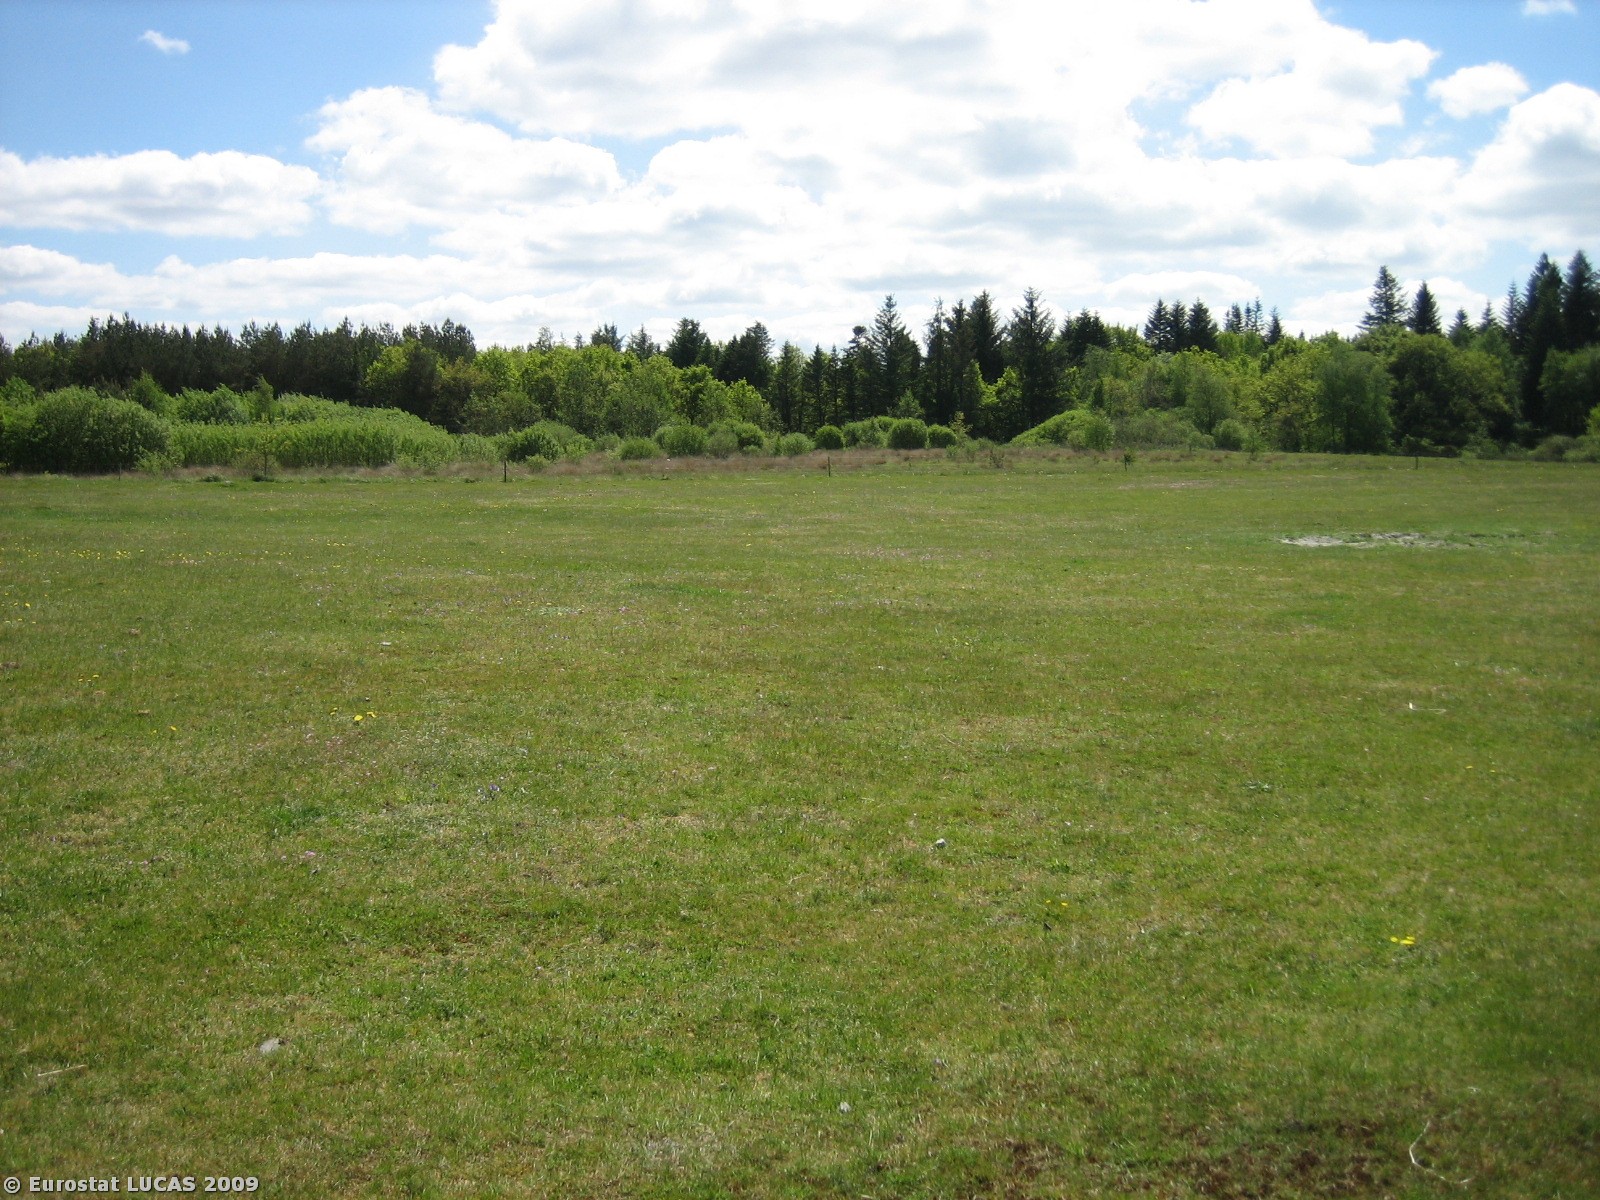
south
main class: Grassland
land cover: Grassland without tree/shrub cover
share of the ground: > 75 %
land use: Residential
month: May
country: DK
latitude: 56.0399
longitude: 8.9899
